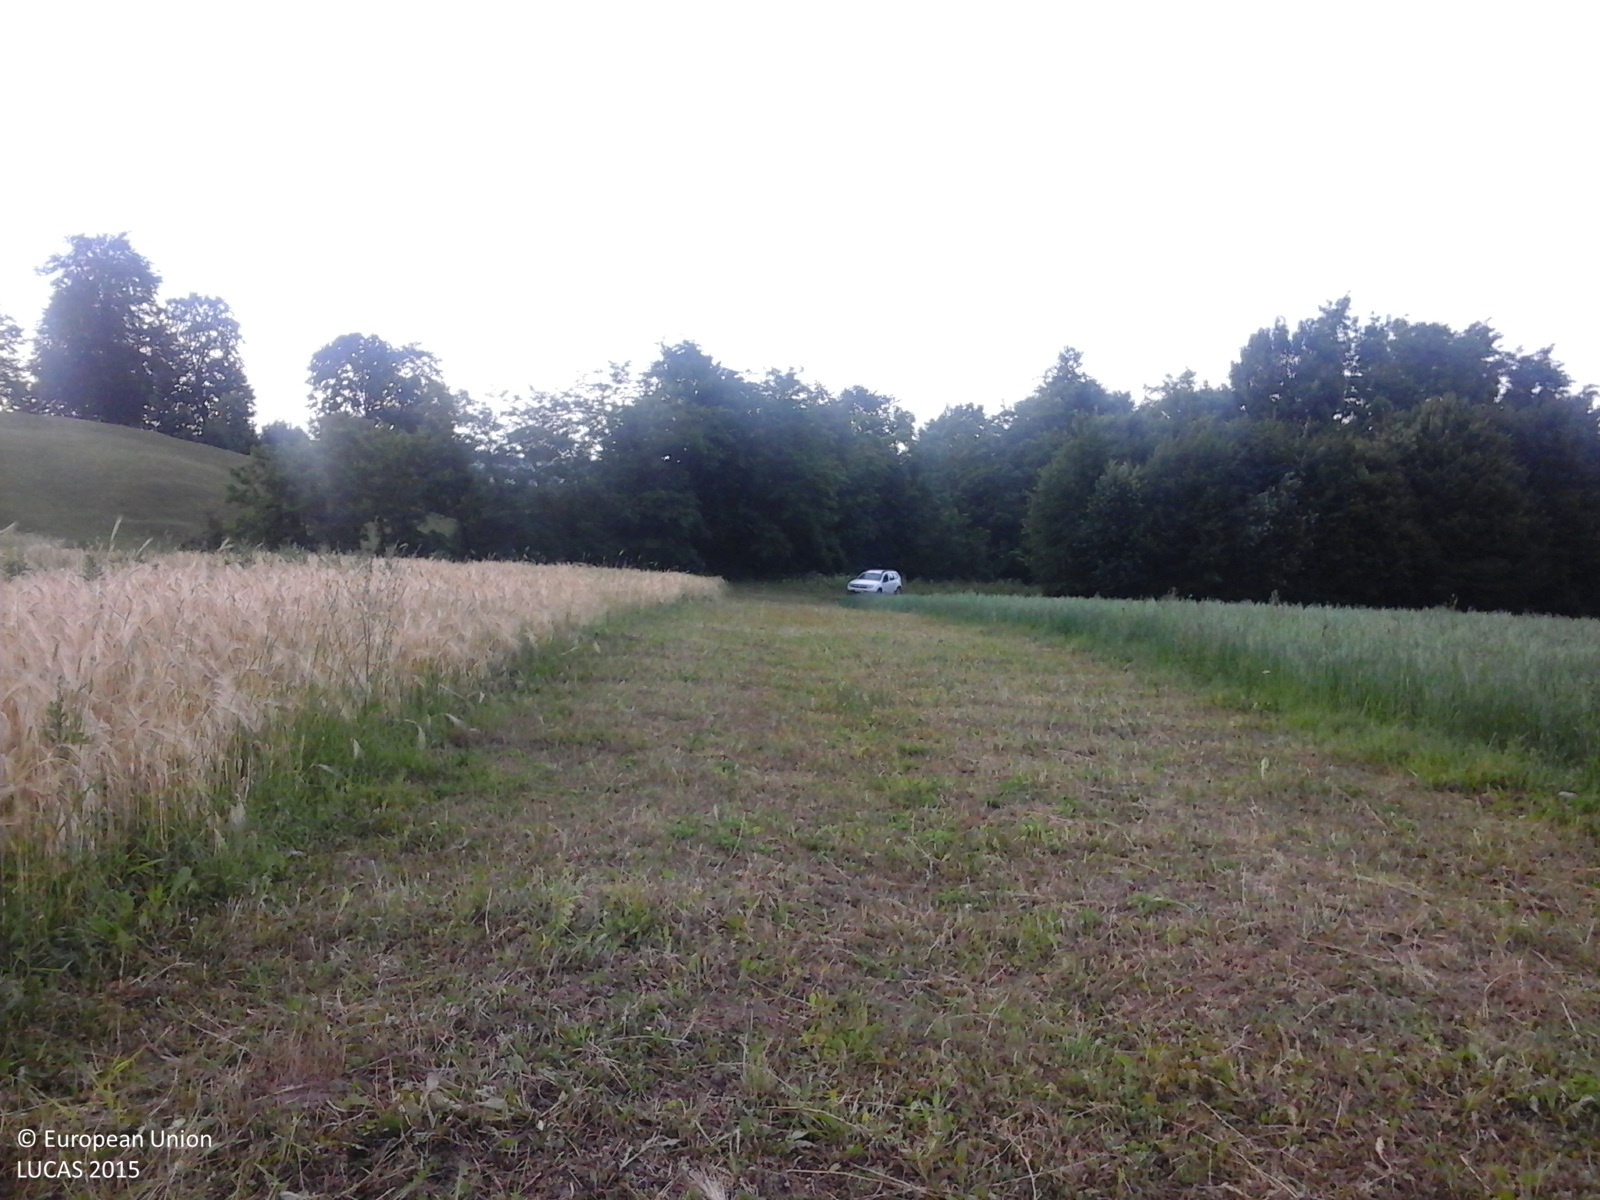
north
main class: Cropland
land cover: Lucerne
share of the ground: > 75 %
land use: Agriculture (excluding fallow land and kitchen gardens)
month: June
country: RO
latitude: 47.4822
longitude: 26.5048
